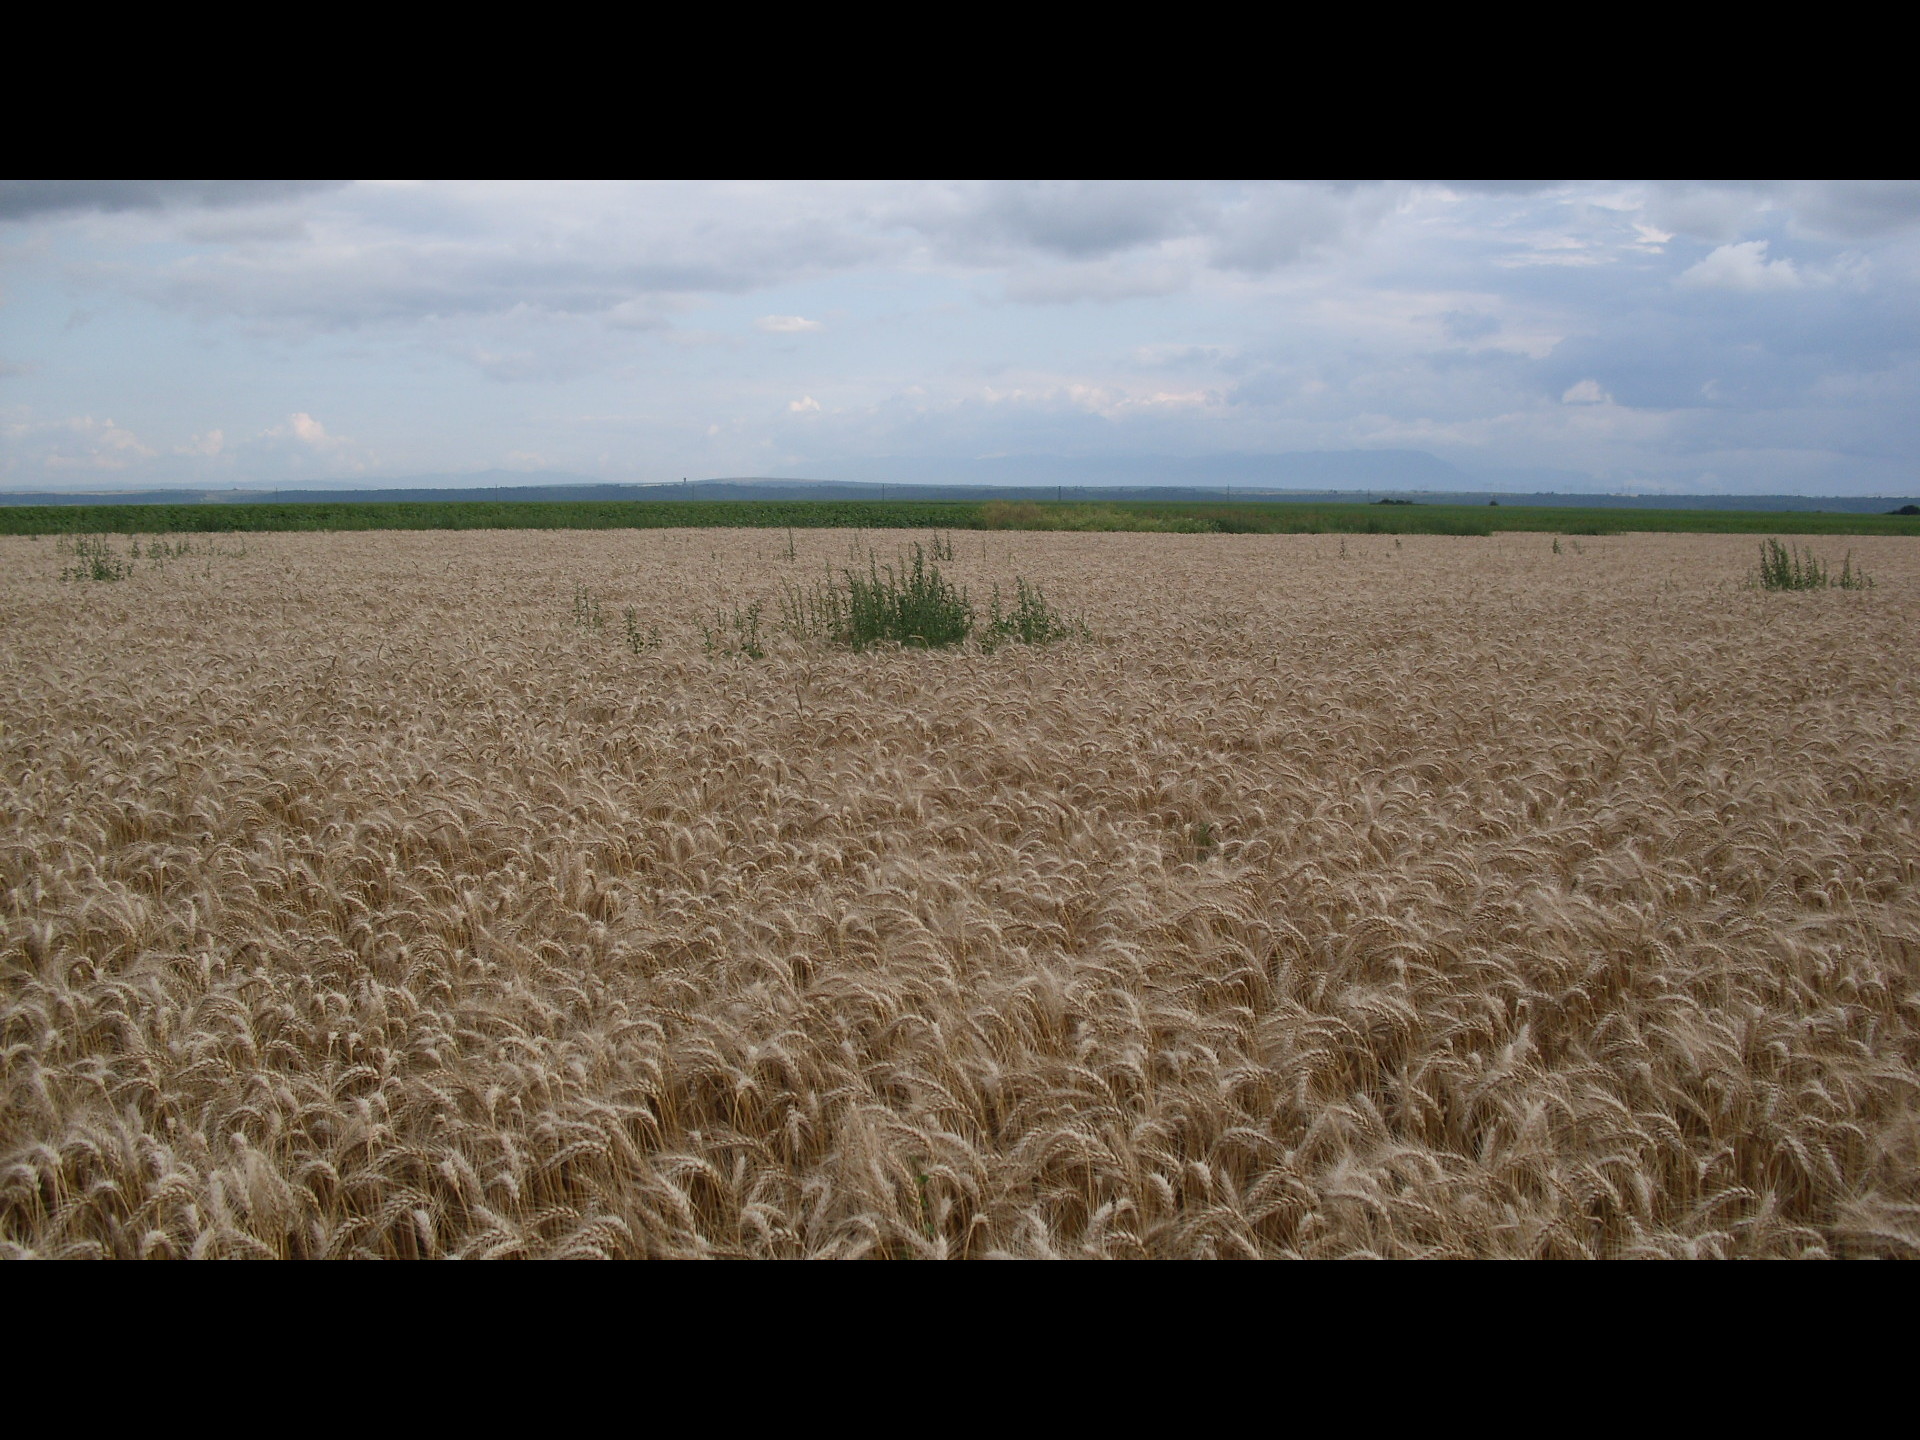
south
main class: Cropland
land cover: Common wheat
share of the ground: 10 - 25 %
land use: Agriculture (excluding fallow land and kitchen gardens)
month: June
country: BG
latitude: 43.5647
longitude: 23.4276
